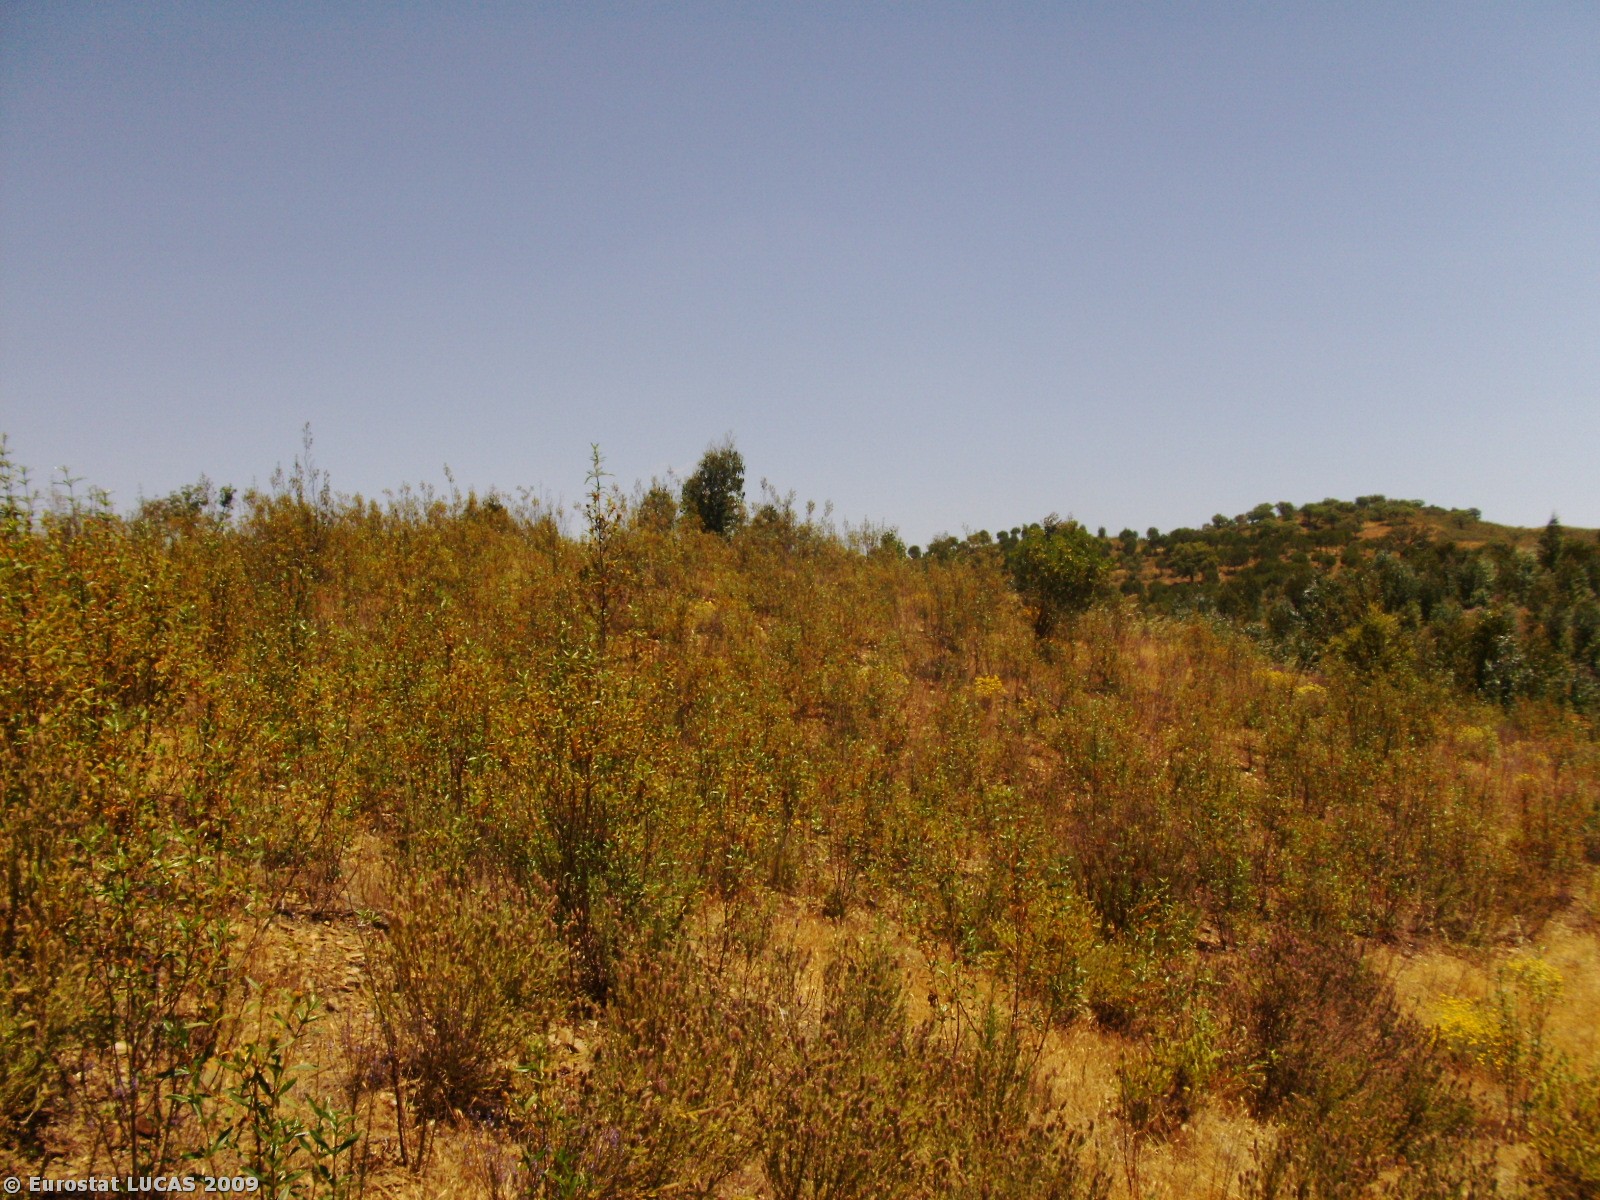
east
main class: Shrubland
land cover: Shrubland without tree cover
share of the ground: 50 - 75 %
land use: Unused
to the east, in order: Shrubland without tree cover; Broadleaved woodland; Tracks; Broadleaved woodland; Tracks; Broadleaved woodland
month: May
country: PT
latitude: 37.4676
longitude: -8.2404
